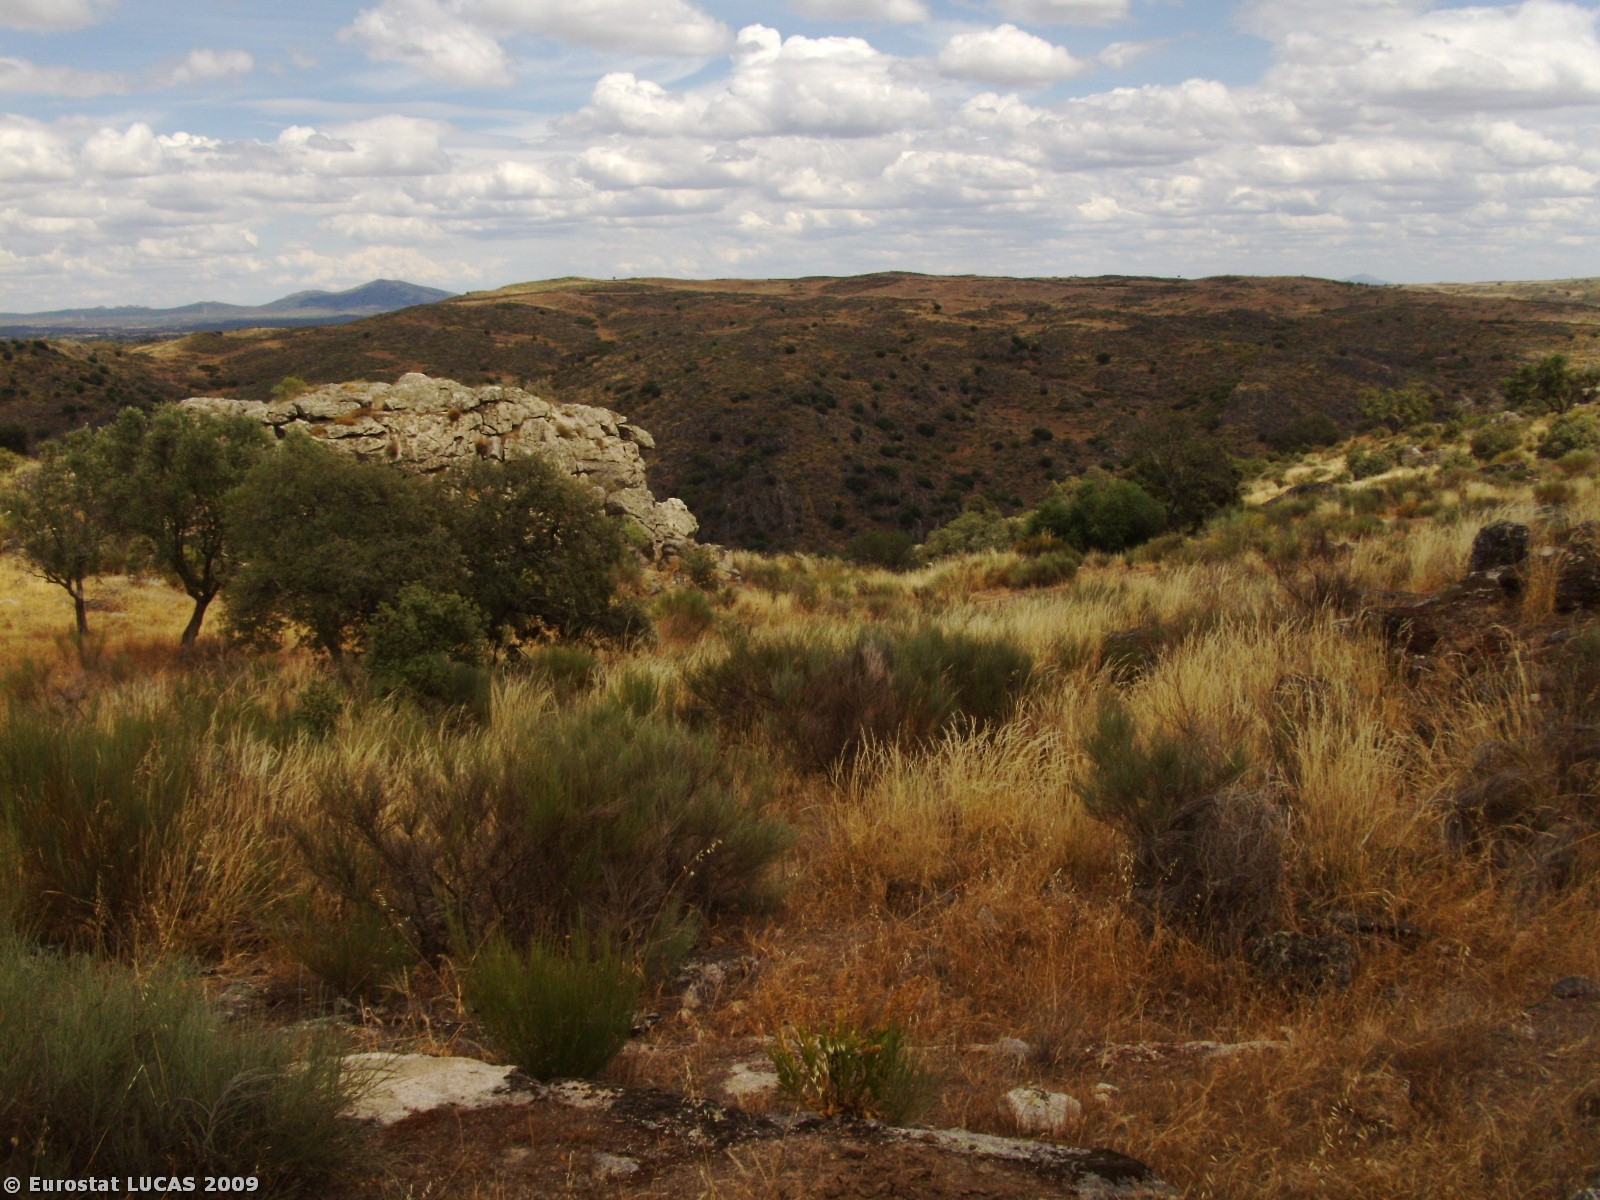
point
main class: Shrubland
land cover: Shrubland with sparse tree cover
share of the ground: > 75 %
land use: Unused
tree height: > 5 m
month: June
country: PT
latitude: 39.8750
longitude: -6.9111
